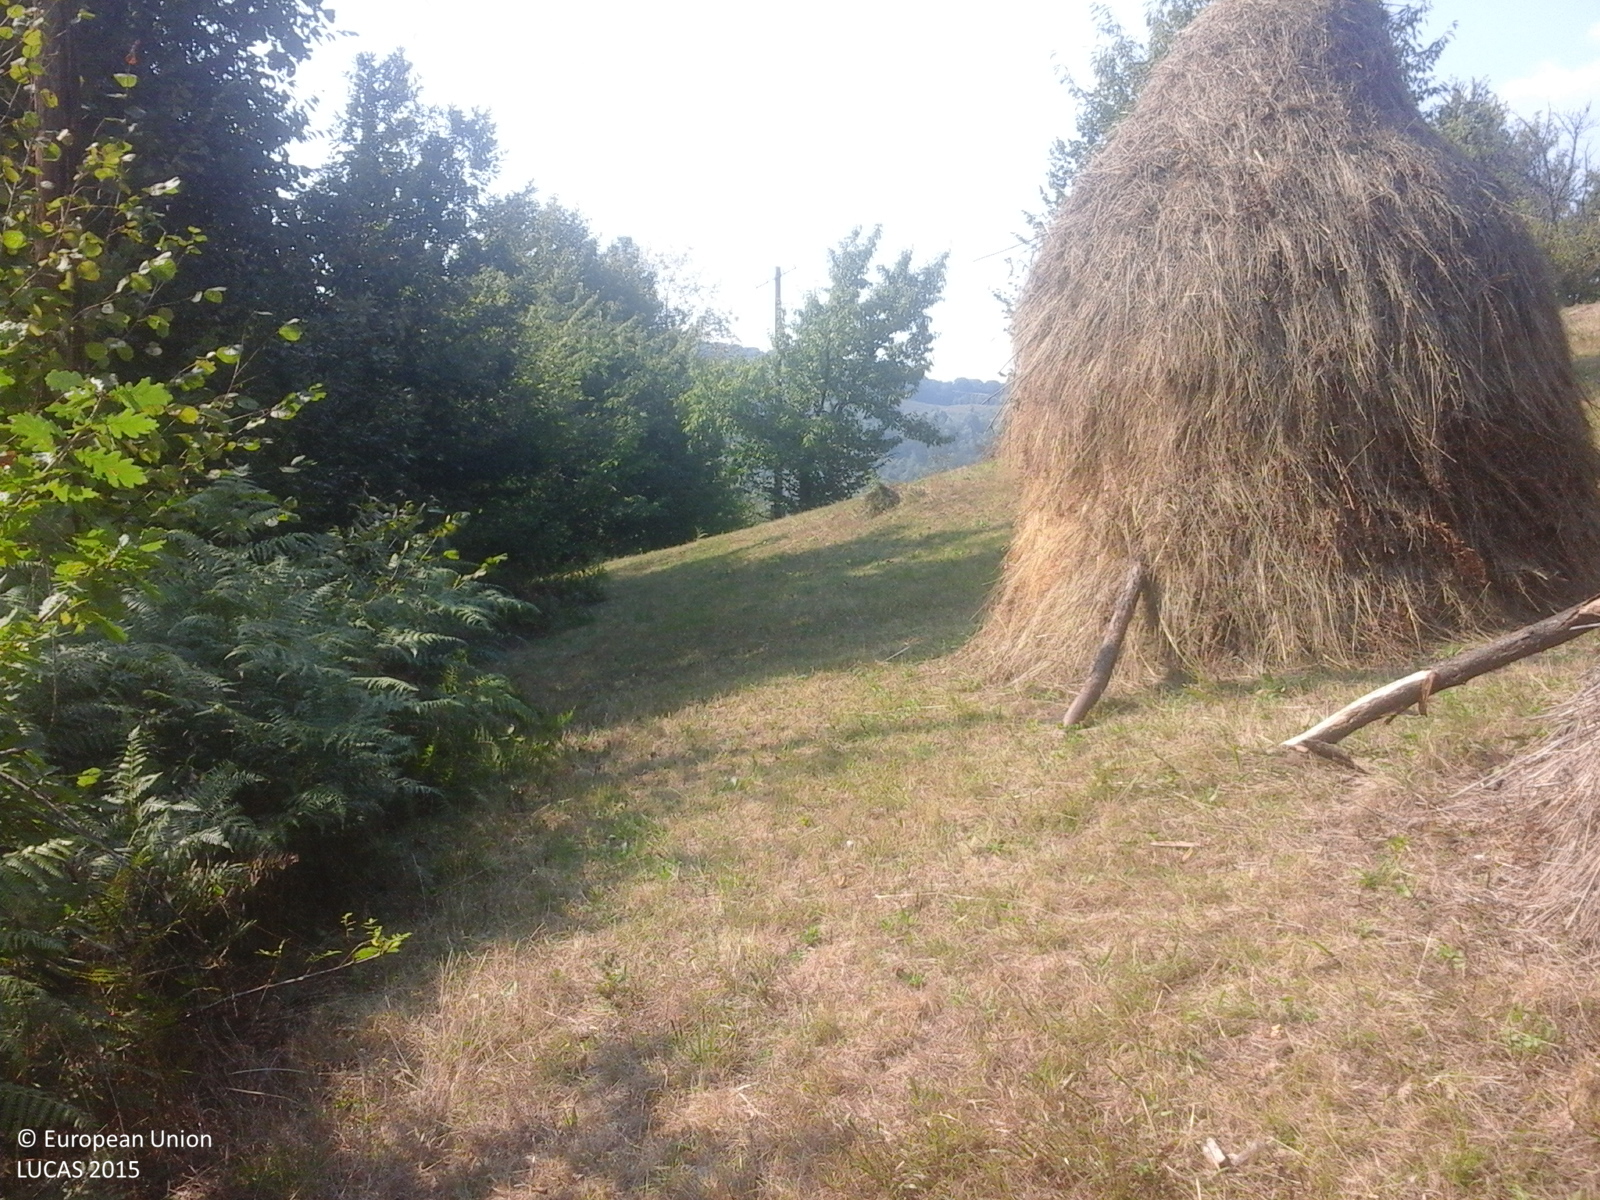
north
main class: Grassland
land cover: Grassland without tree/shrub cover
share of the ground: > 75 %
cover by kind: herbaceous plants 100 %
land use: Agriculture (excluding fallow land and kitchen gardens)
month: August
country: RO
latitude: 46.3507
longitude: 22.5919
